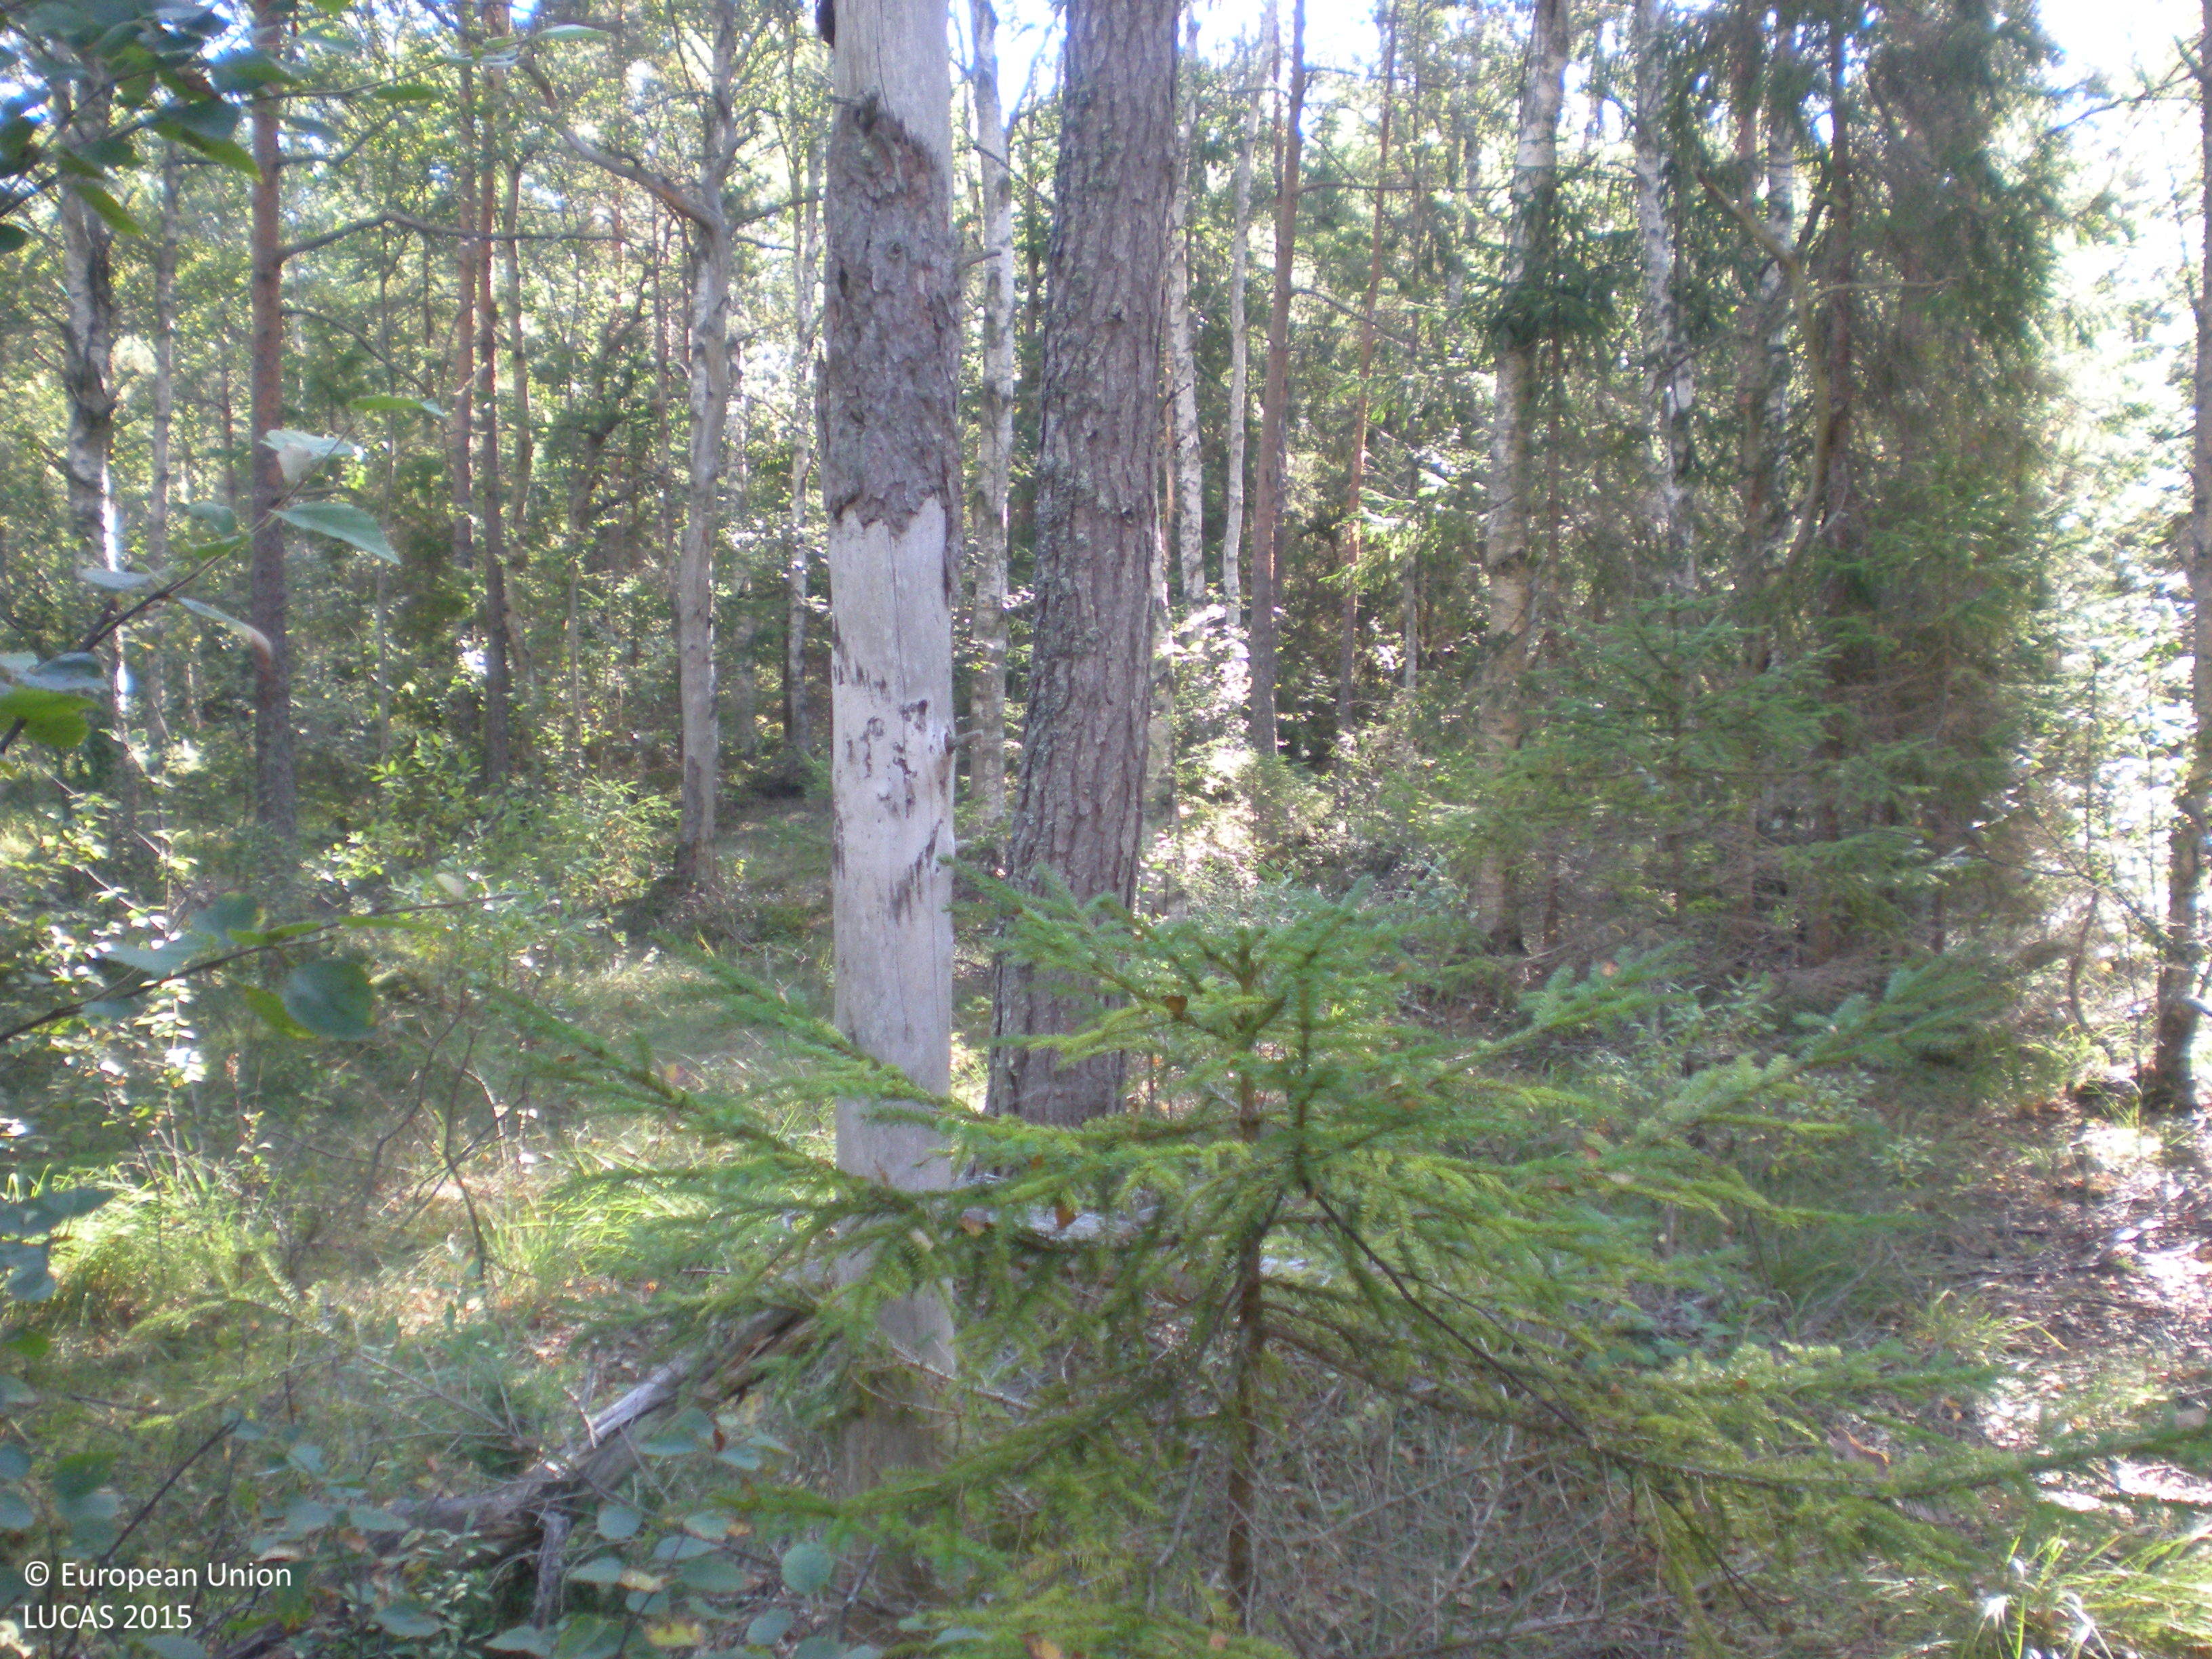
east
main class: Woodland
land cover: Pine dominated mixed woodland
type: boreal forest
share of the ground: 50 - 75 %
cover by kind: coniferous forest trees 40 %, broadleaved forest trees 25 %, herbaceous plants 15 %, lichens and mosses 10 %, shrubs 5 %
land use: Forestry
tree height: > 5 m
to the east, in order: Pine dominated mixed woodland; Ditches and canals; Pine dominated mixed woodland; Other mixed woodland; Broadleaved woodland; Other mixed woodland; Spruce dominated mixed woodland; Broadleaved woodland
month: August
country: SE
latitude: 60.5775
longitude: 17.1614
